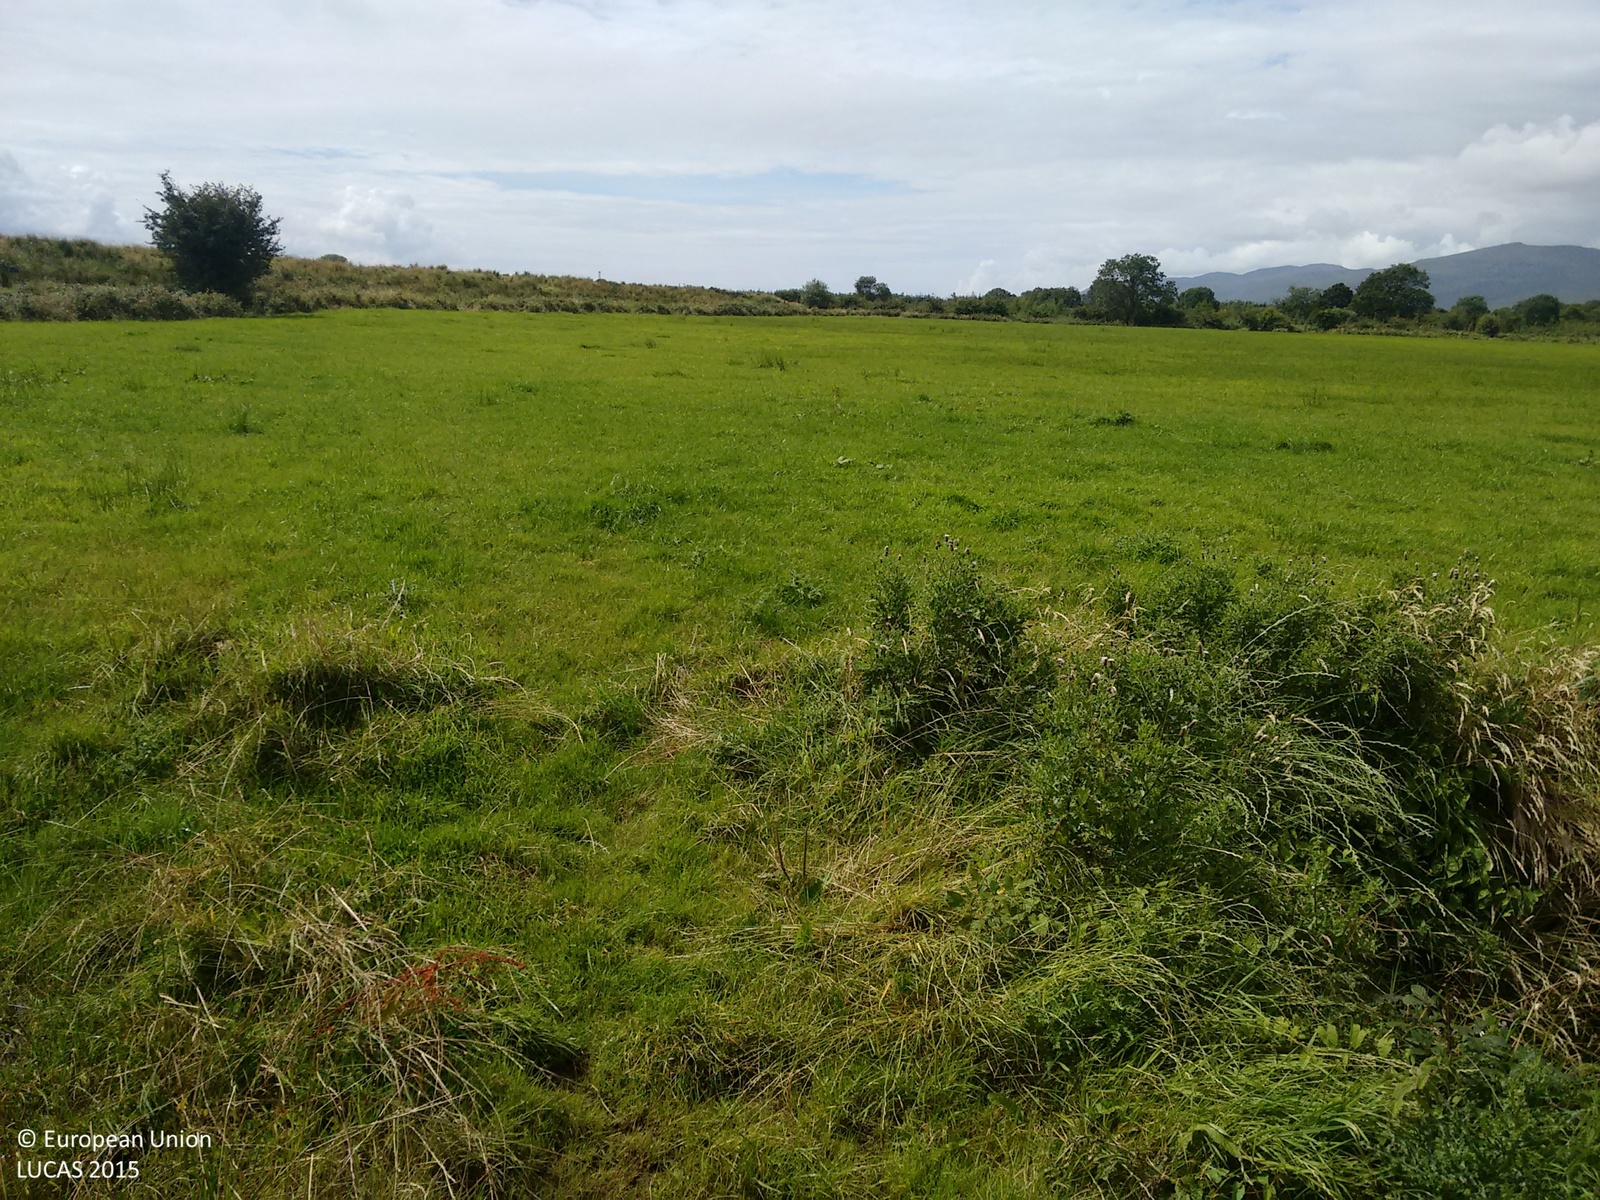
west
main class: Grassland
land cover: Grassland without tree/shrub cover
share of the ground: > 75 %
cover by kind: herbaceous plants 100 %
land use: Agriculture (excluding fallow land and kitchen gardens)
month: August
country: IE
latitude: 52.1616
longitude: -9.7292
